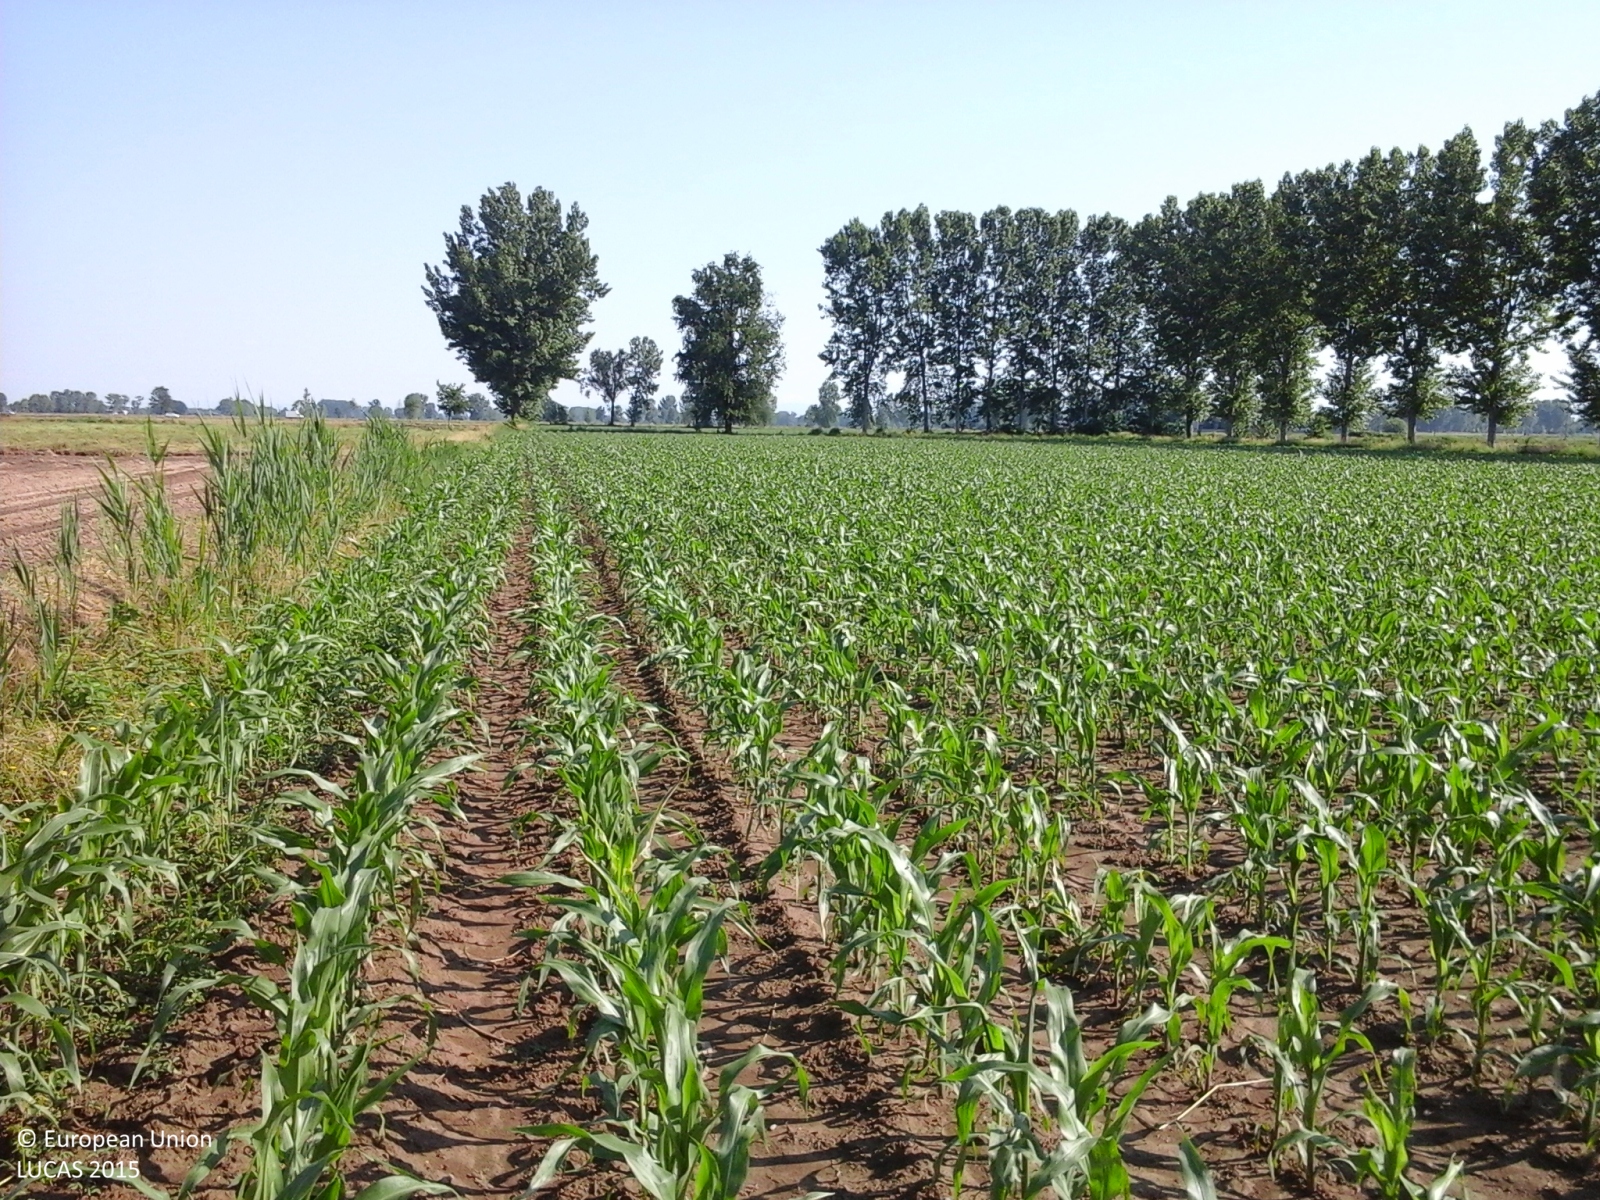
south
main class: Cropland
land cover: Maize
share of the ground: 25 - 50 %
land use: Agriculture (excluding fallow land and kitchen gardens)
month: May
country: IT
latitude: 45.3415
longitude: 9.6306
